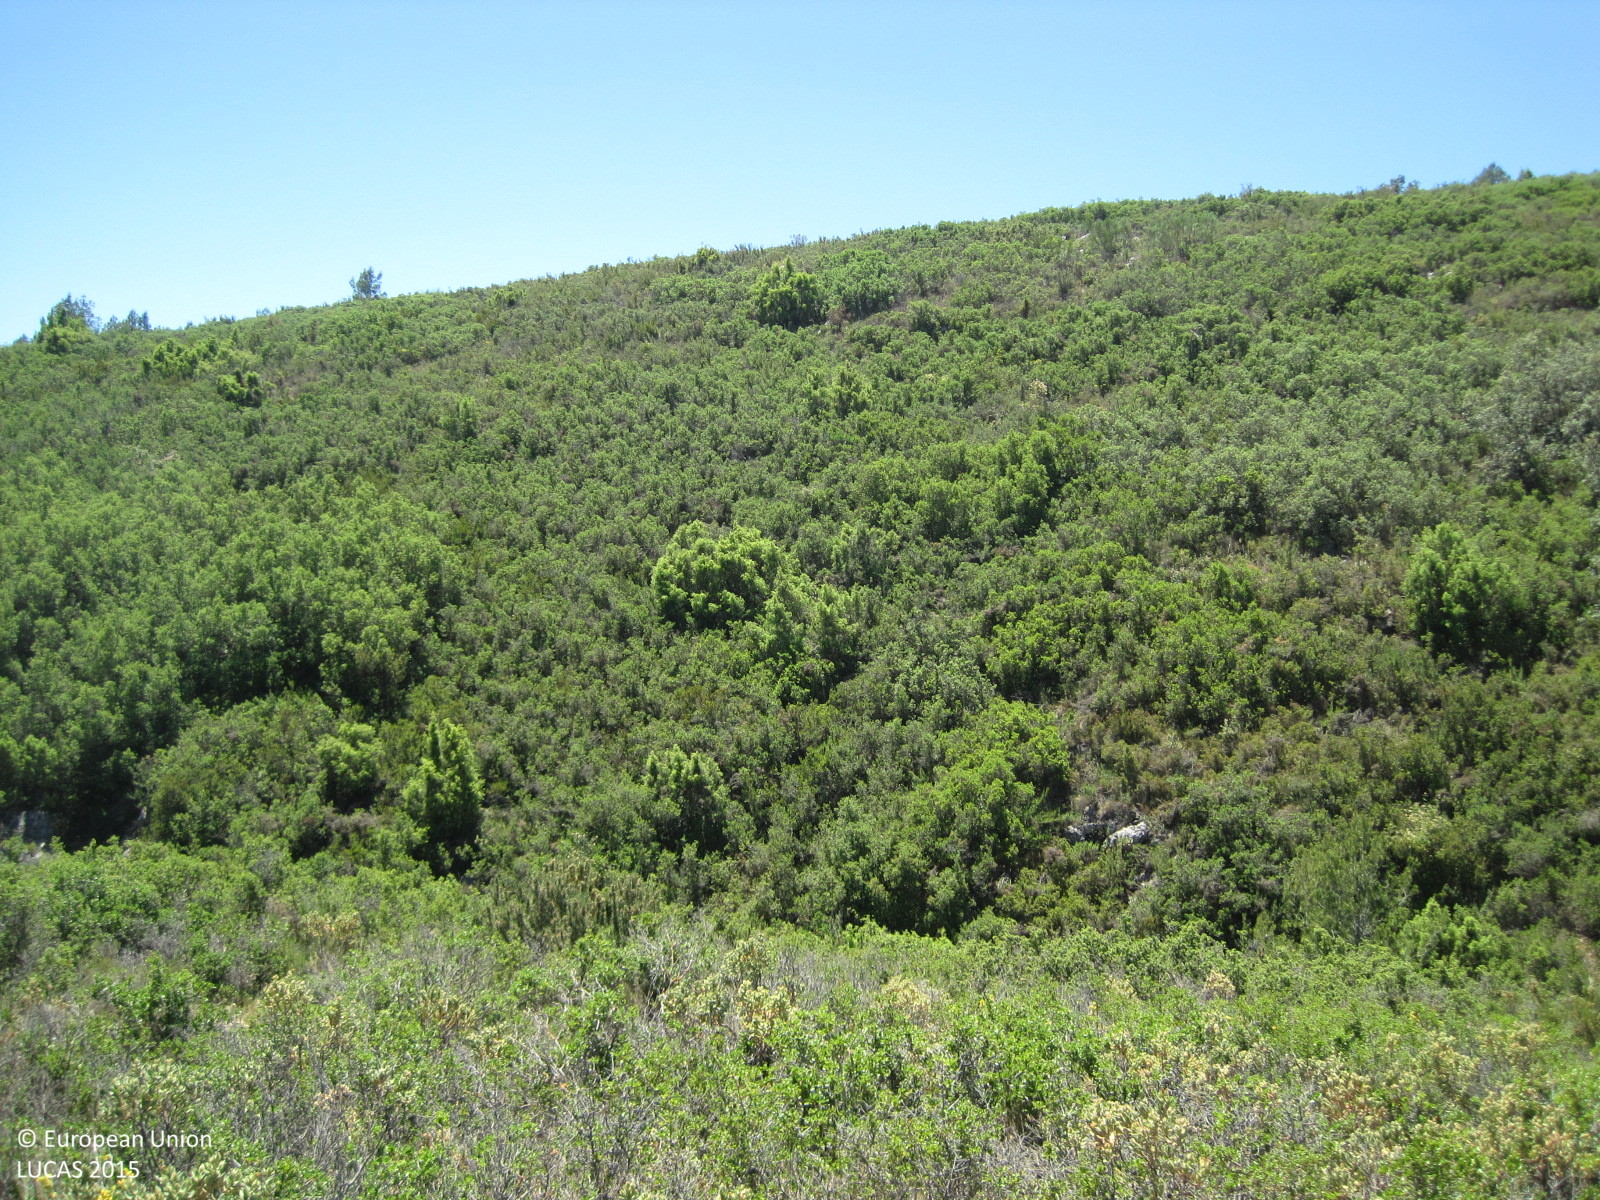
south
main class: Shrubland
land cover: Shrubland without tree cover
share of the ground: > 75 %
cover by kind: shrubs 95 %, consolidated bare surface 5 %
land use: Semi-natural and natural areas not in use
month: May
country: ES
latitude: 39.4254
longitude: -0.8607
